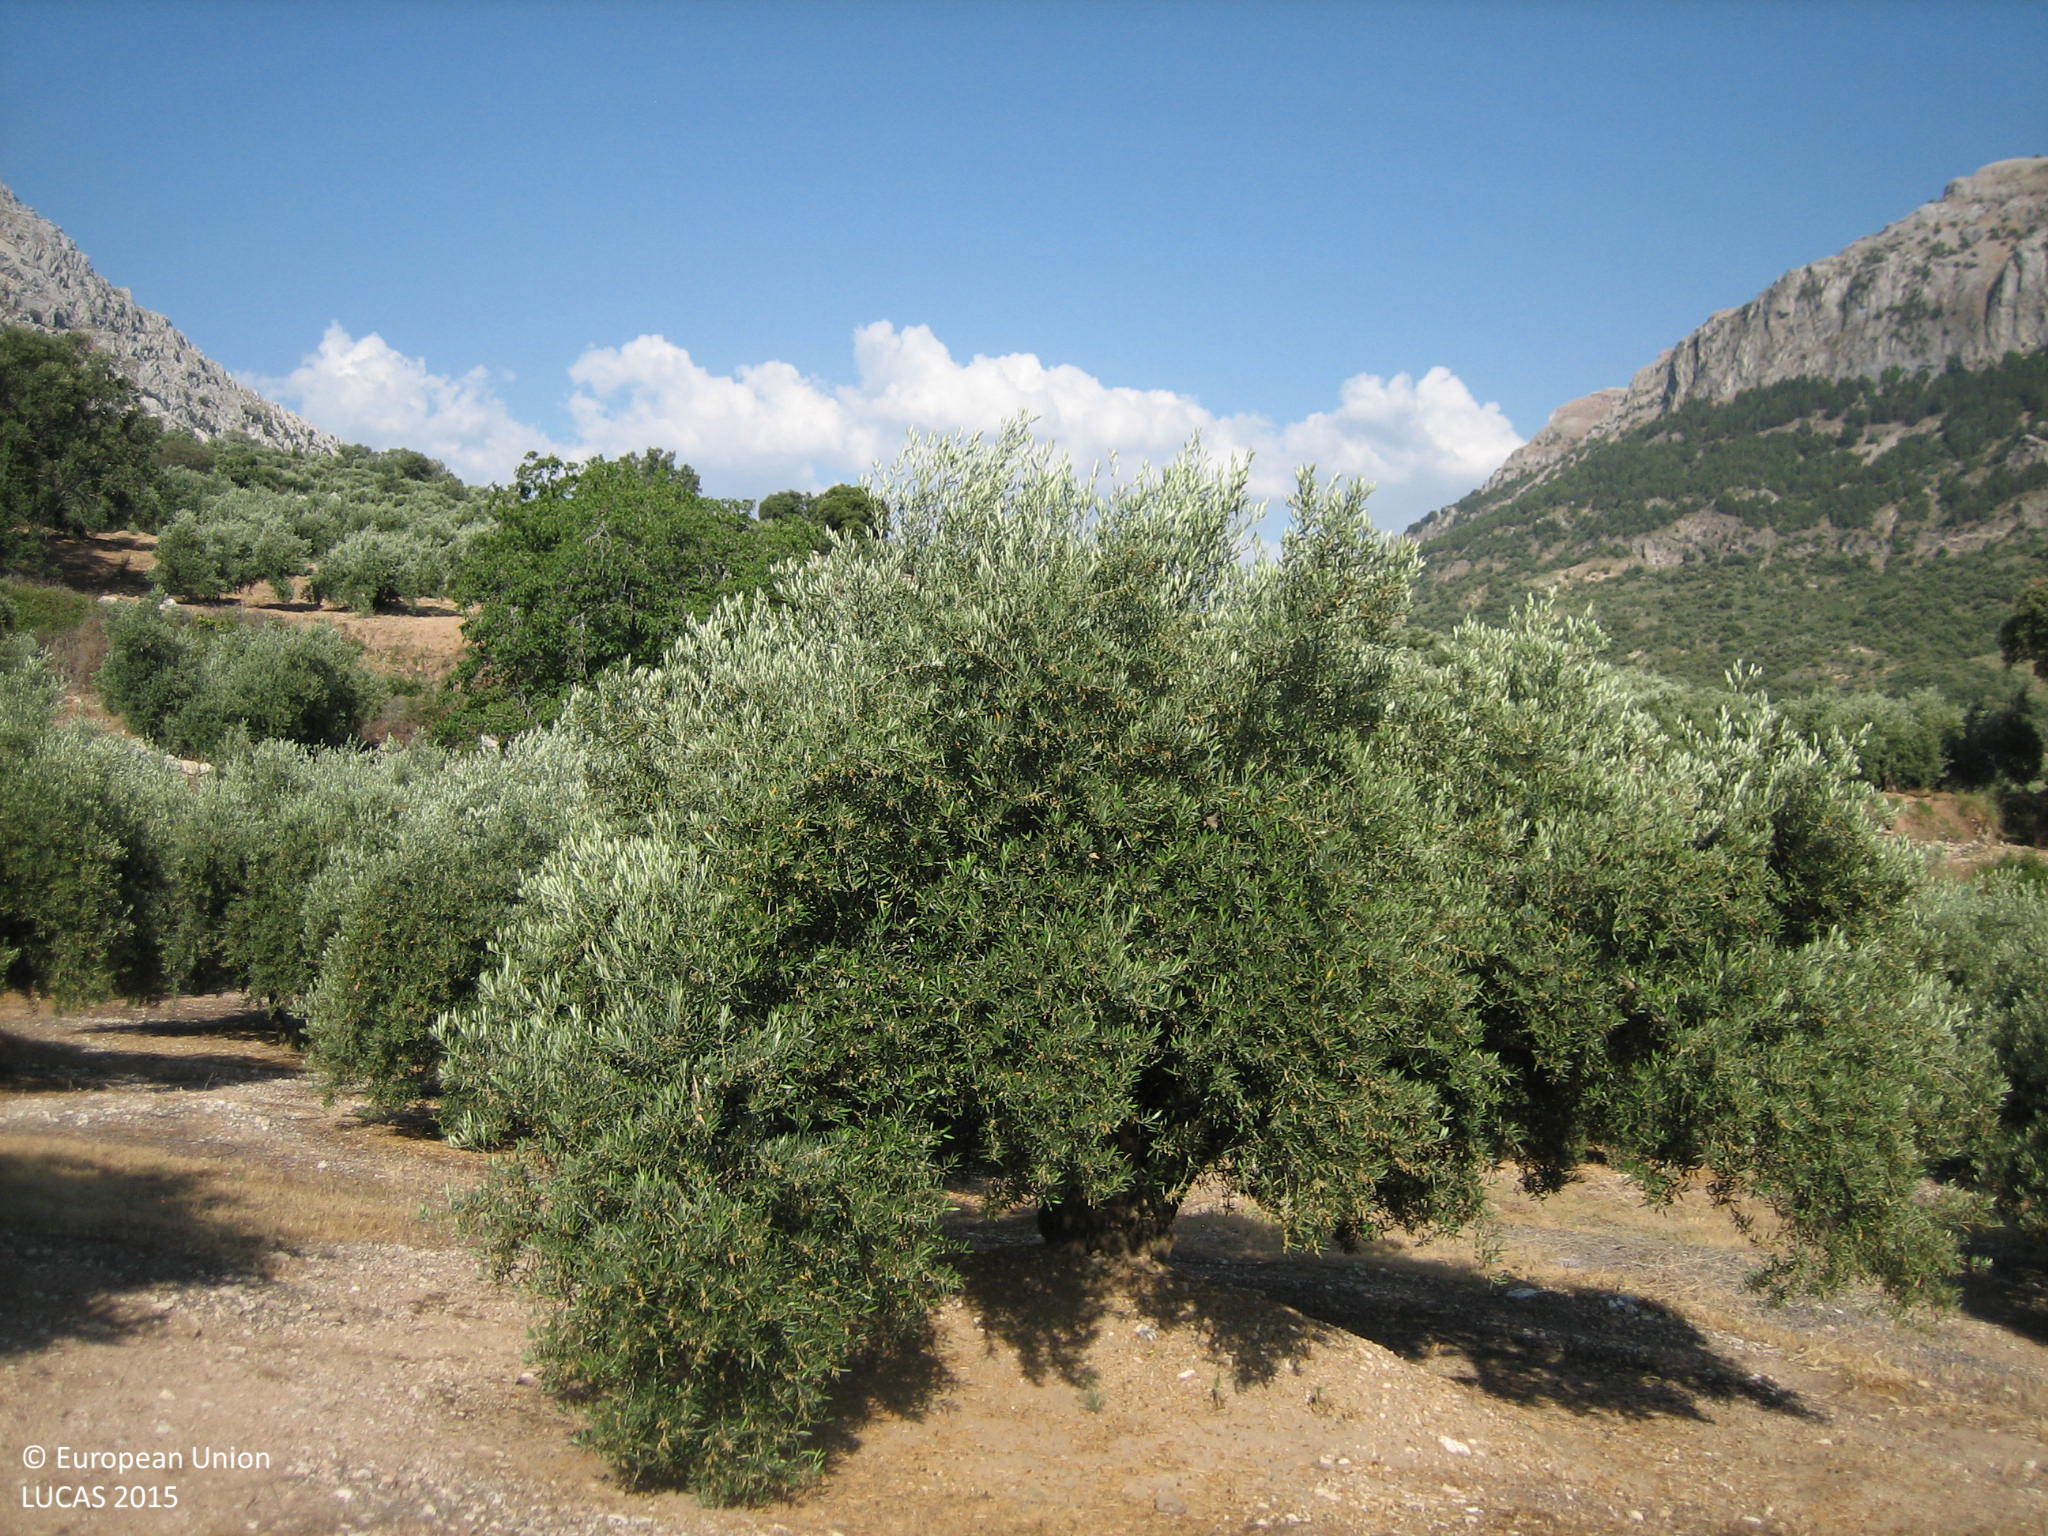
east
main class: Cropland
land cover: Olive groves
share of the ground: 25 - 50 %
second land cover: Spontaneously vegetated surfaces
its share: 10 - 25 %
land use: Agriculture (excluding fallow land and kitchen gardens)
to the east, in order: Olive groves; Spontaneously vegetated surfaces; Tracks; Dry stone walls; Single bushes/trees; Tracks; Dry stone walls; Olive groves; Dry stone walls; Olive groves
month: June
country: ES
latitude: 37.6197
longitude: -3.7864
